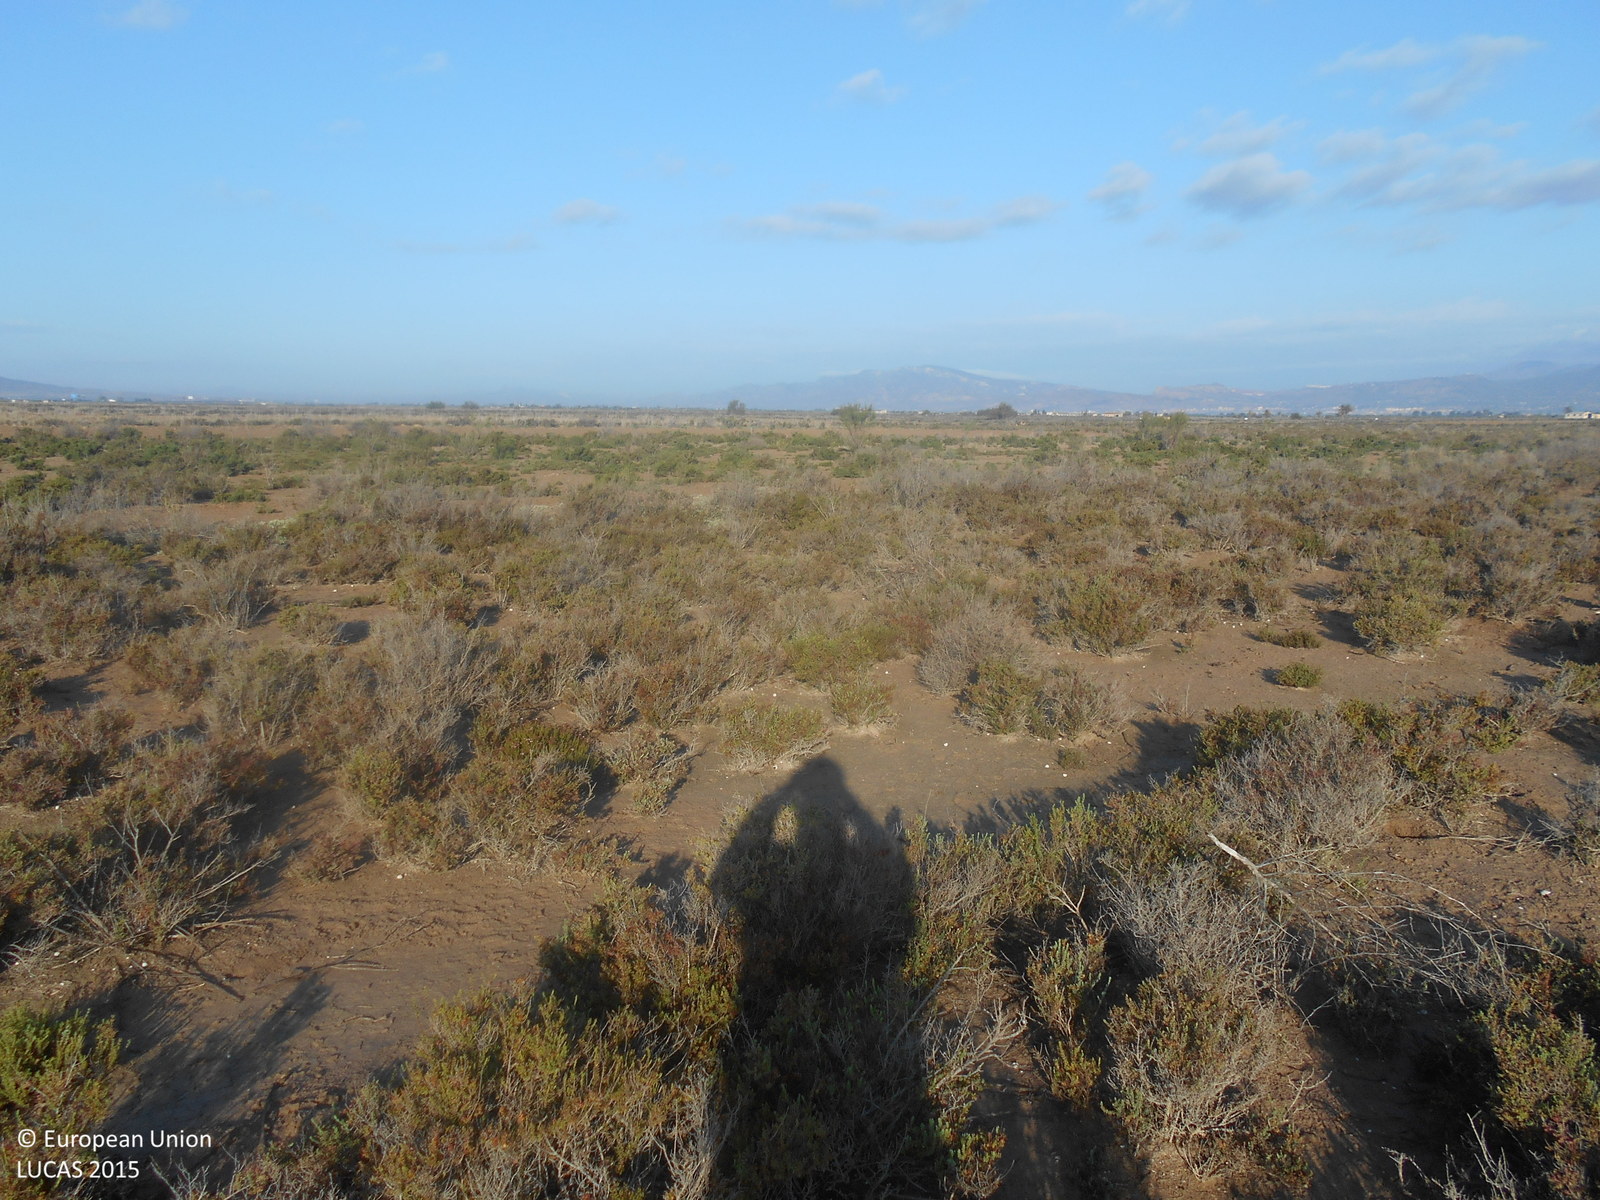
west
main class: Shrubland
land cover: Shrubland without tree cover
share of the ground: 50 - 75 %
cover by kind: shrubs 60 %, unconsolidated bare surface 40 %
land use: Semi-natural and natural areas not in use
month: April
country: ES
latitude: 37.7382
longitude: -1.3863
